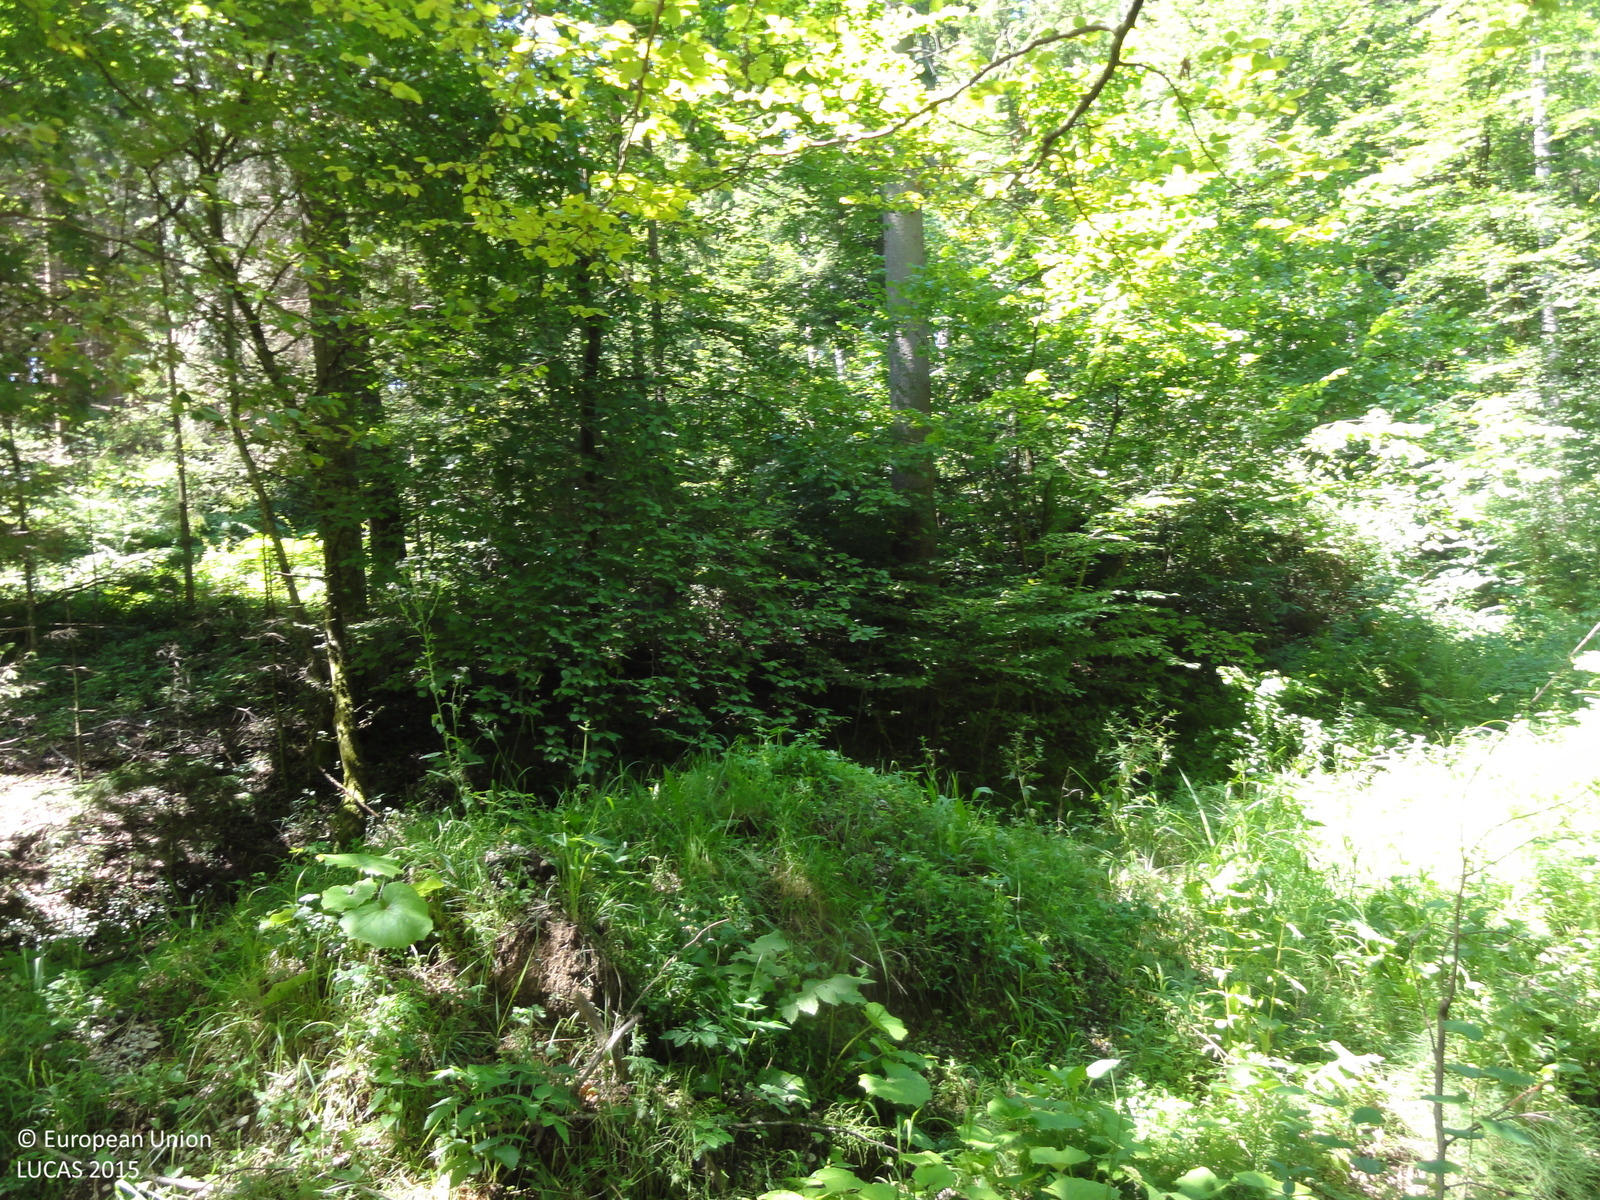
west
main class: Woodland
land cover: Spruce dominated mixed woodland
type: mountainous beech forest
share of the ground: > 75 %
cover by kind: coniferous forest trees 60 %, broadleaved forest trees 35 %, unconsolidated bare surface 5 %
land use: Forestry
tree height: > 5 m
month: July
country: SI
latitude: 46.3030
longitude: 15.0741
